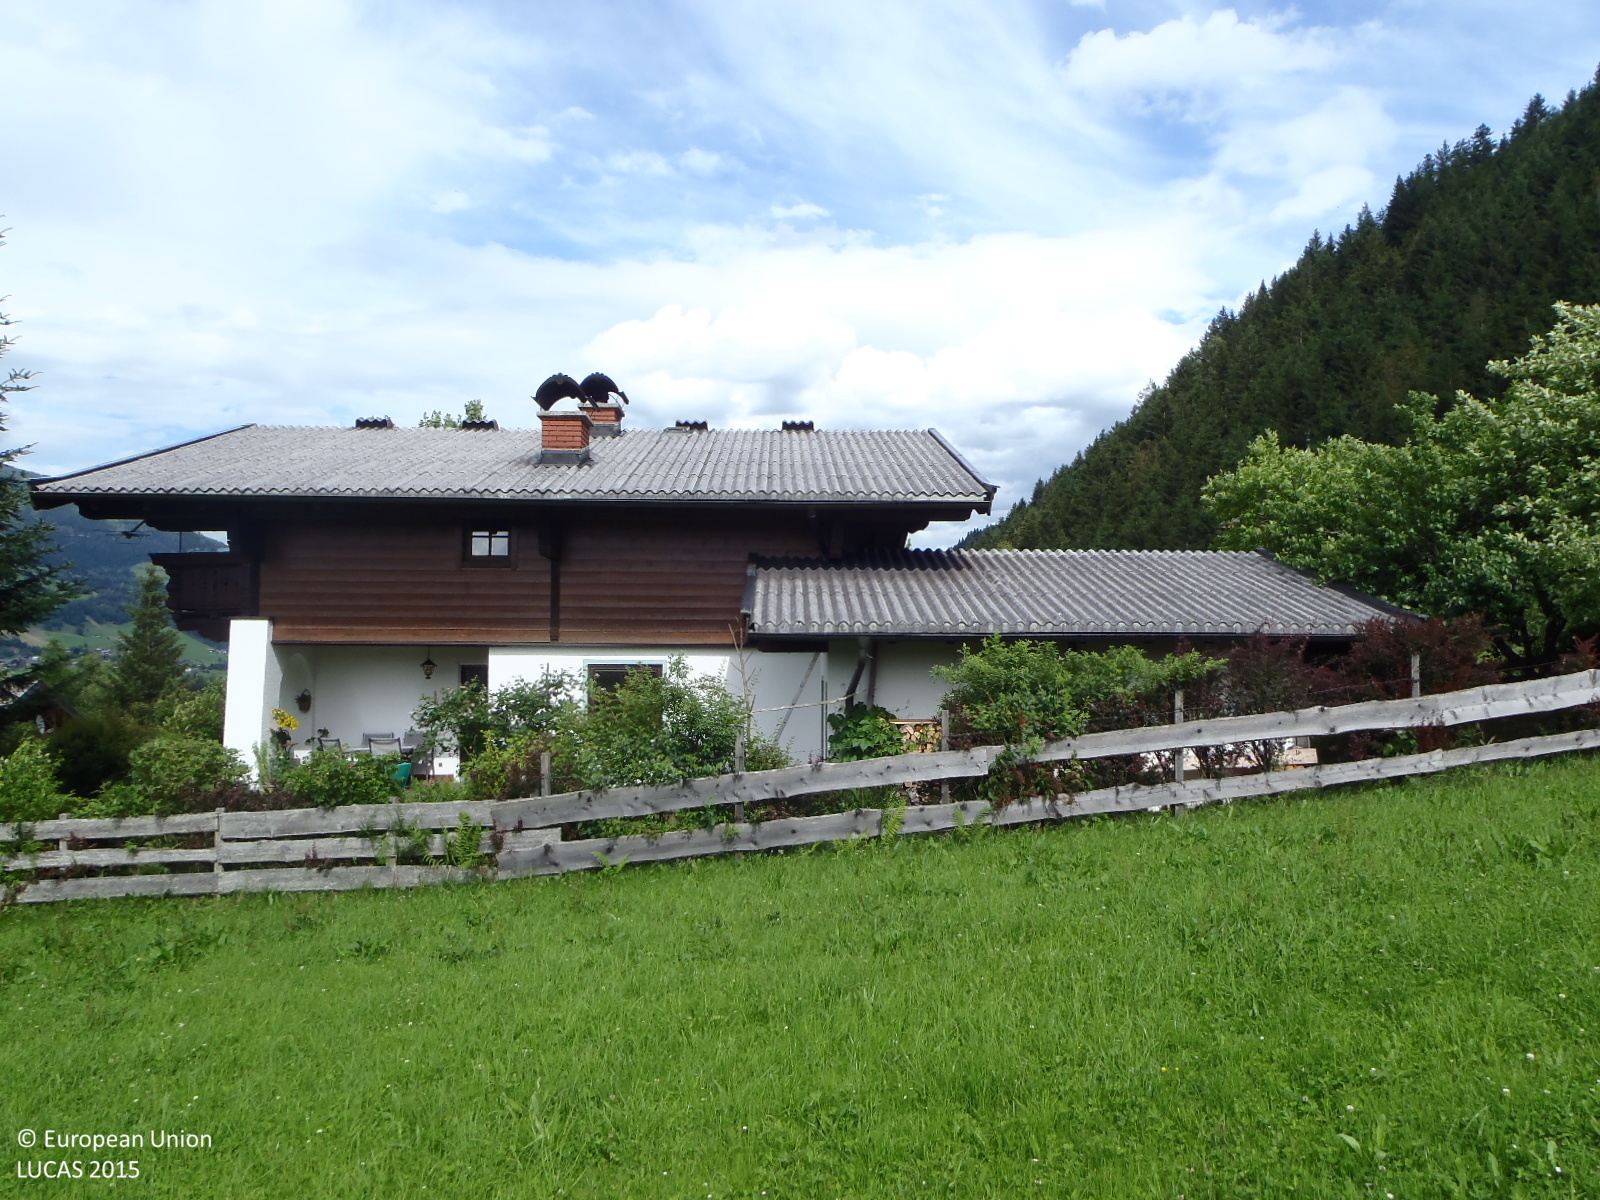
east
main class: Grassland
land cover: Grassland without tree/shrub cover
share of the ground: > 75 %
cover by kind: herbaceous plants 100 %
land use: Agriculture (excluding fallow land and kitchen gardens)
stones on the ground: < 10 %
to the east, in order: Grassland without tree/shrub cover; Artificial constructions in urban areas; Rivers and streams; Artificial constructions in urban areas; Managed hedges; Grassland without tree/shrub cover; Fences; Grassland without tree/shrub cover
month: June
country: AT
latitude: 47.2763
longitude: 12.5230
